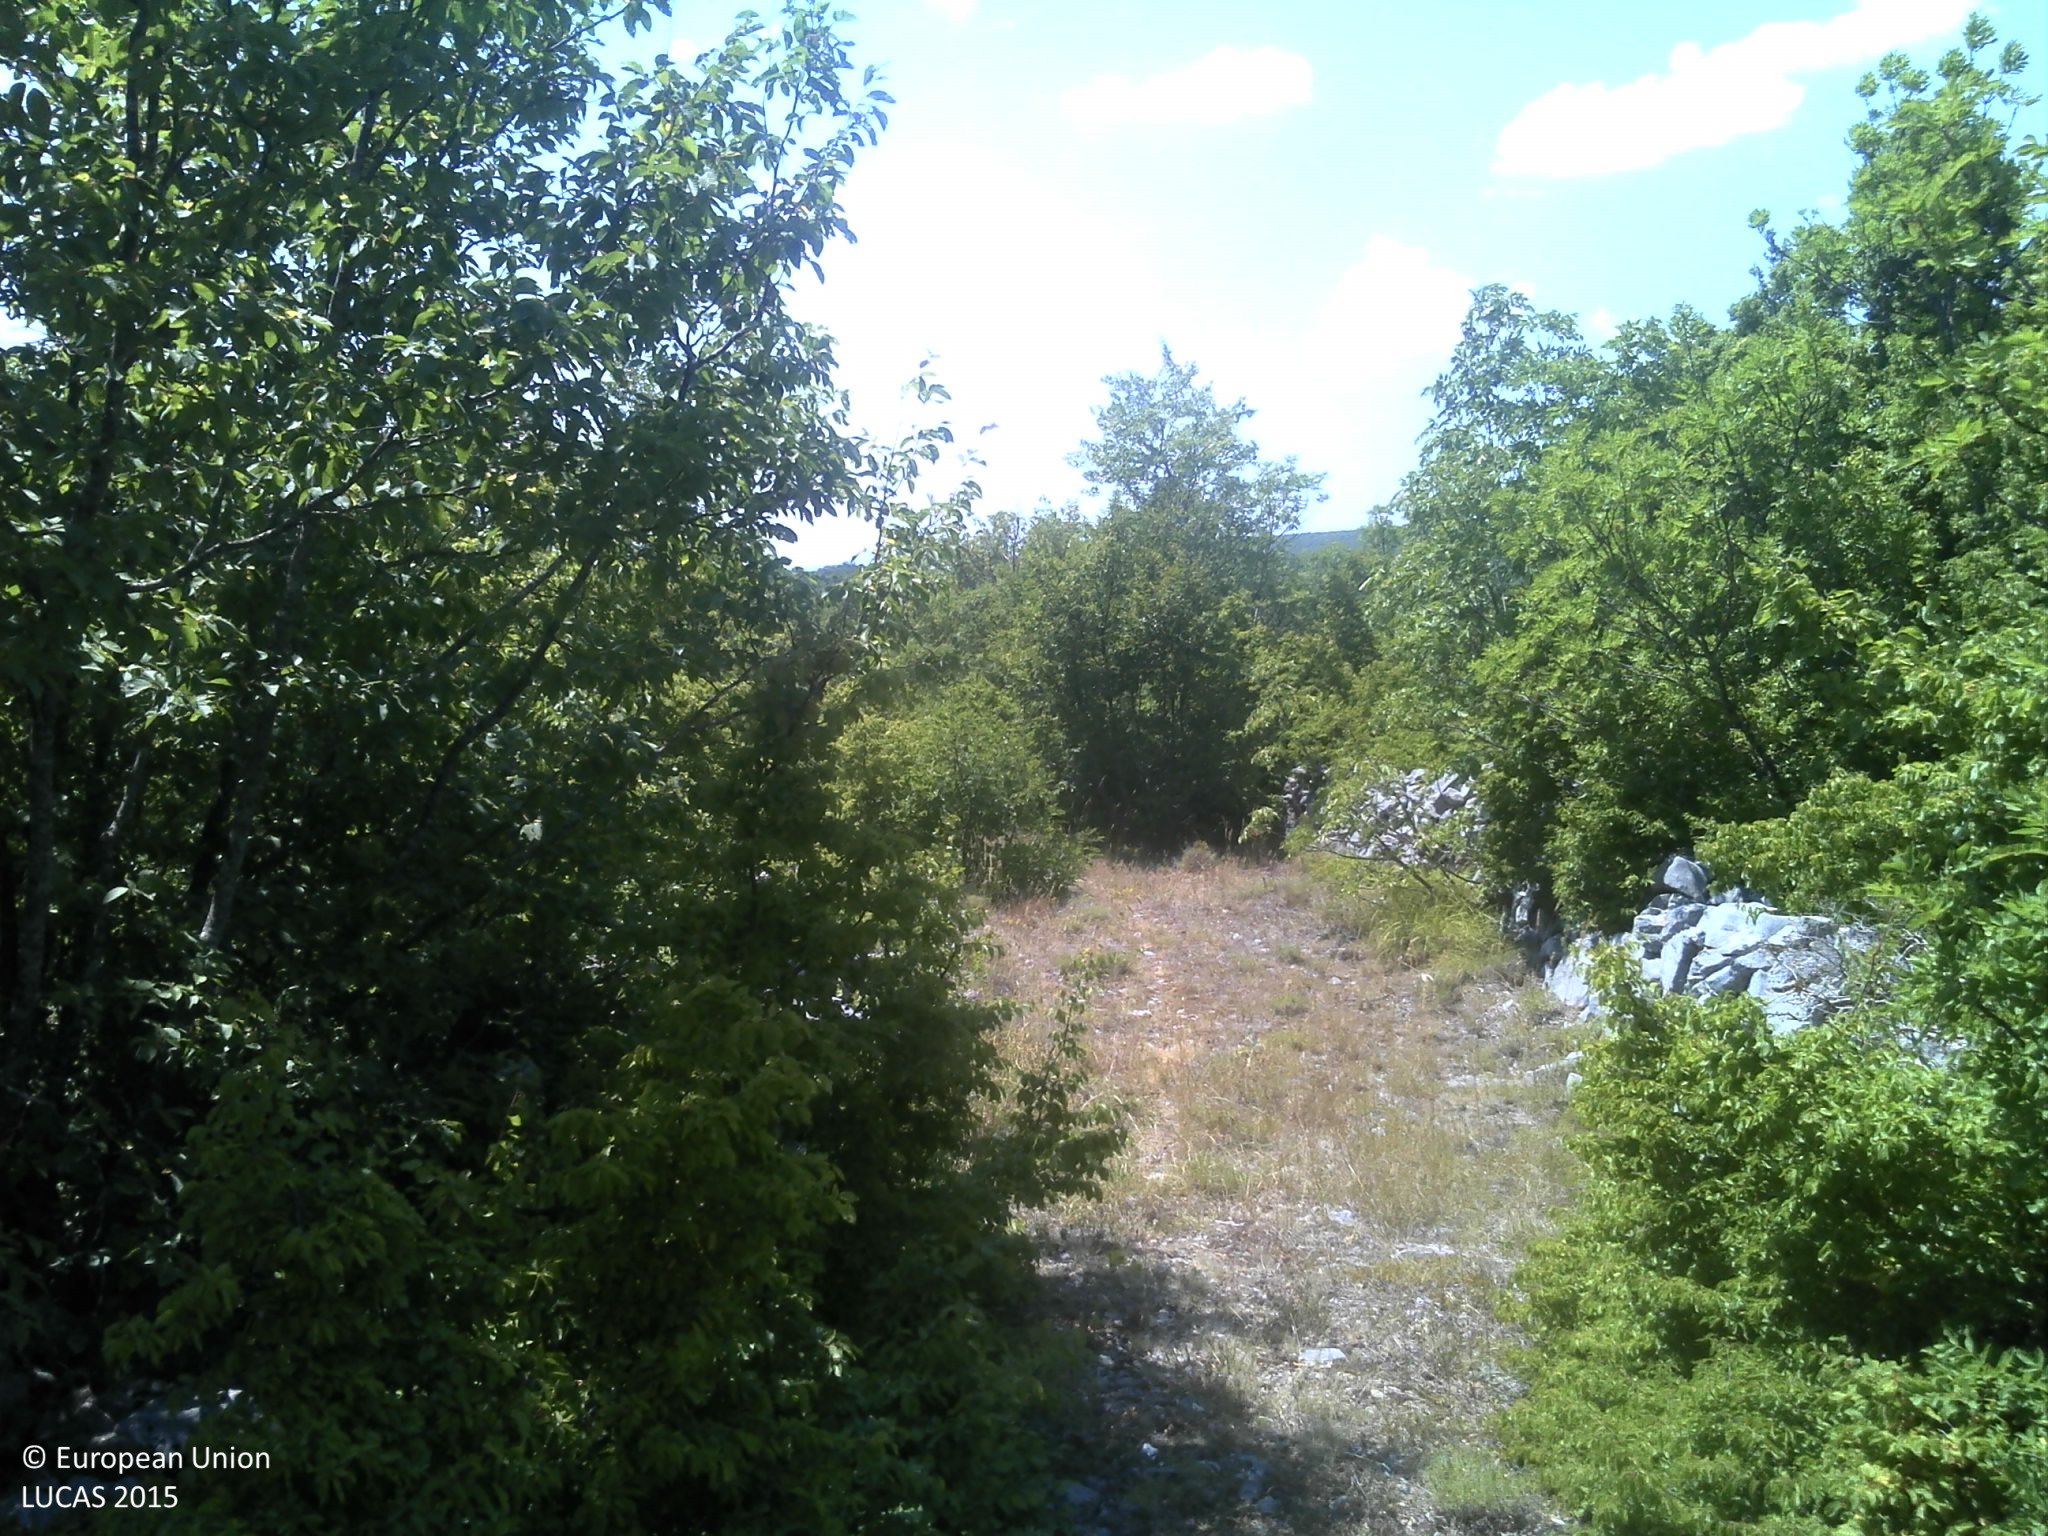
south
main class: Shrubland
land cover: Shrubland with sparse tree cover
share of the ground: > 75 %
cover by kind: shrubs 70 %, herbaceous plants 15 %, broadleaved forest trees 5 %, consolidated bare surface 5 %, unconsolidated bare surface 5 %
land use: Semi-natural and natural areas not in use
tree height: > 5 m
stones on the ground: < 10 %
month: July
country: HR
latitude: 43.4949
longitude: 17.0530
